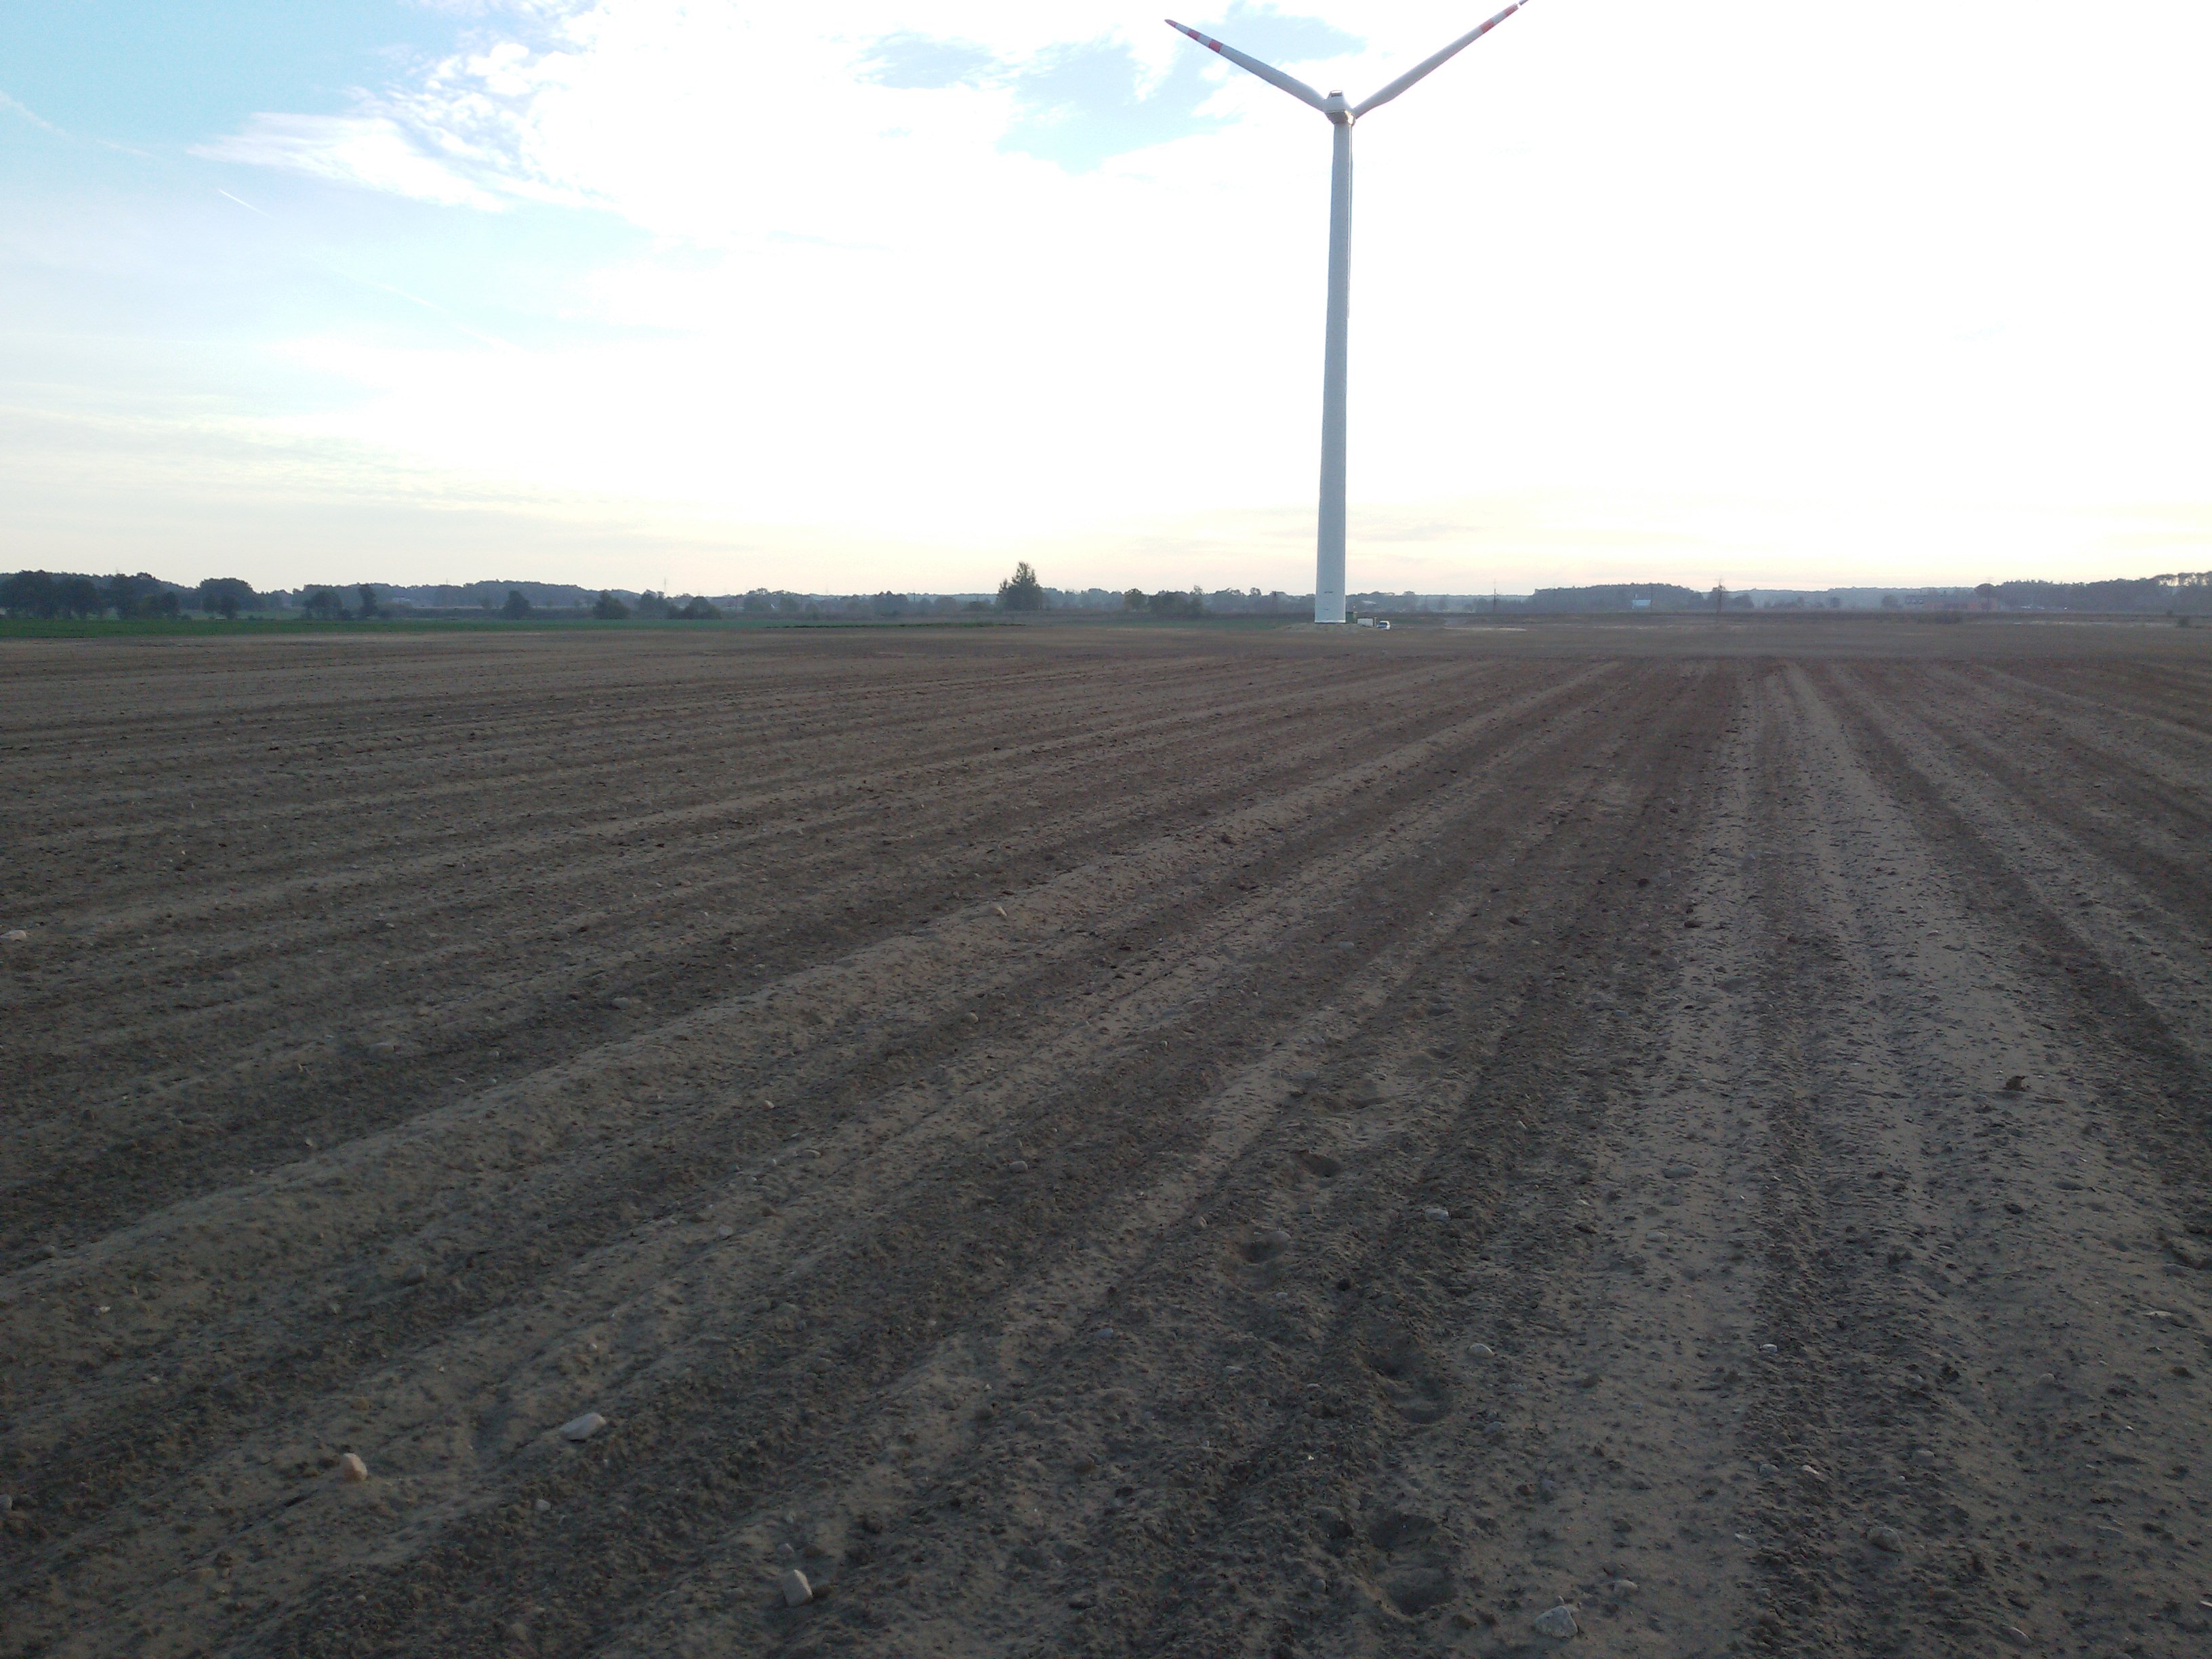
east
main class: Cropland
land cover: Rye
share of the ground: < 10 %
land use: Agriculture (excluding fallow land and kitchen gardens)
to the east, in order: Rye
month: October
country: PL
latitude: 51.6608
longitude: 17.3704
